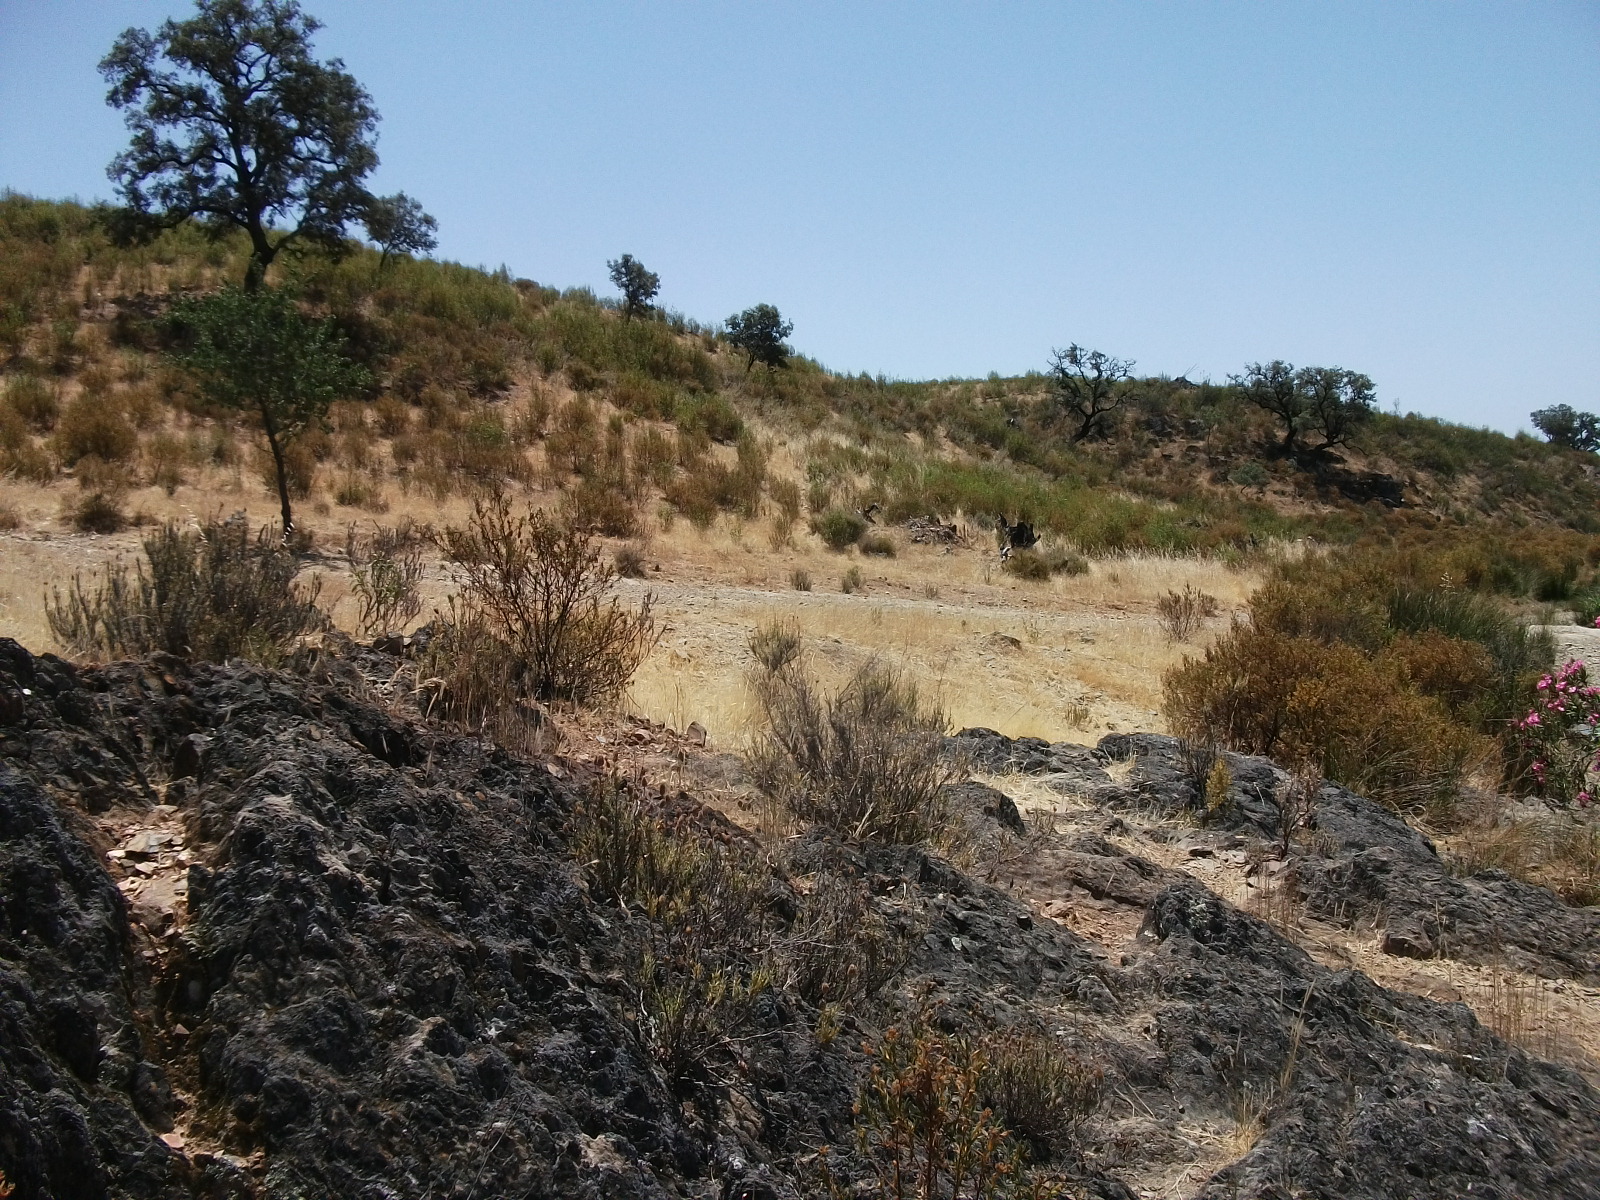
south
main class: Shrubland
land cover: Shrubland without tree cover
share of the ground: 25 - 50 %
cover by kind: shrubs 45 %, herbaceous plants 40 %, unconsolidated bare surface 15 %
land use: Agriculture (excluding fallow land and kitchen gardens)
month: June
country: ES
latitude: 37.5670
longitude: -6.9246
